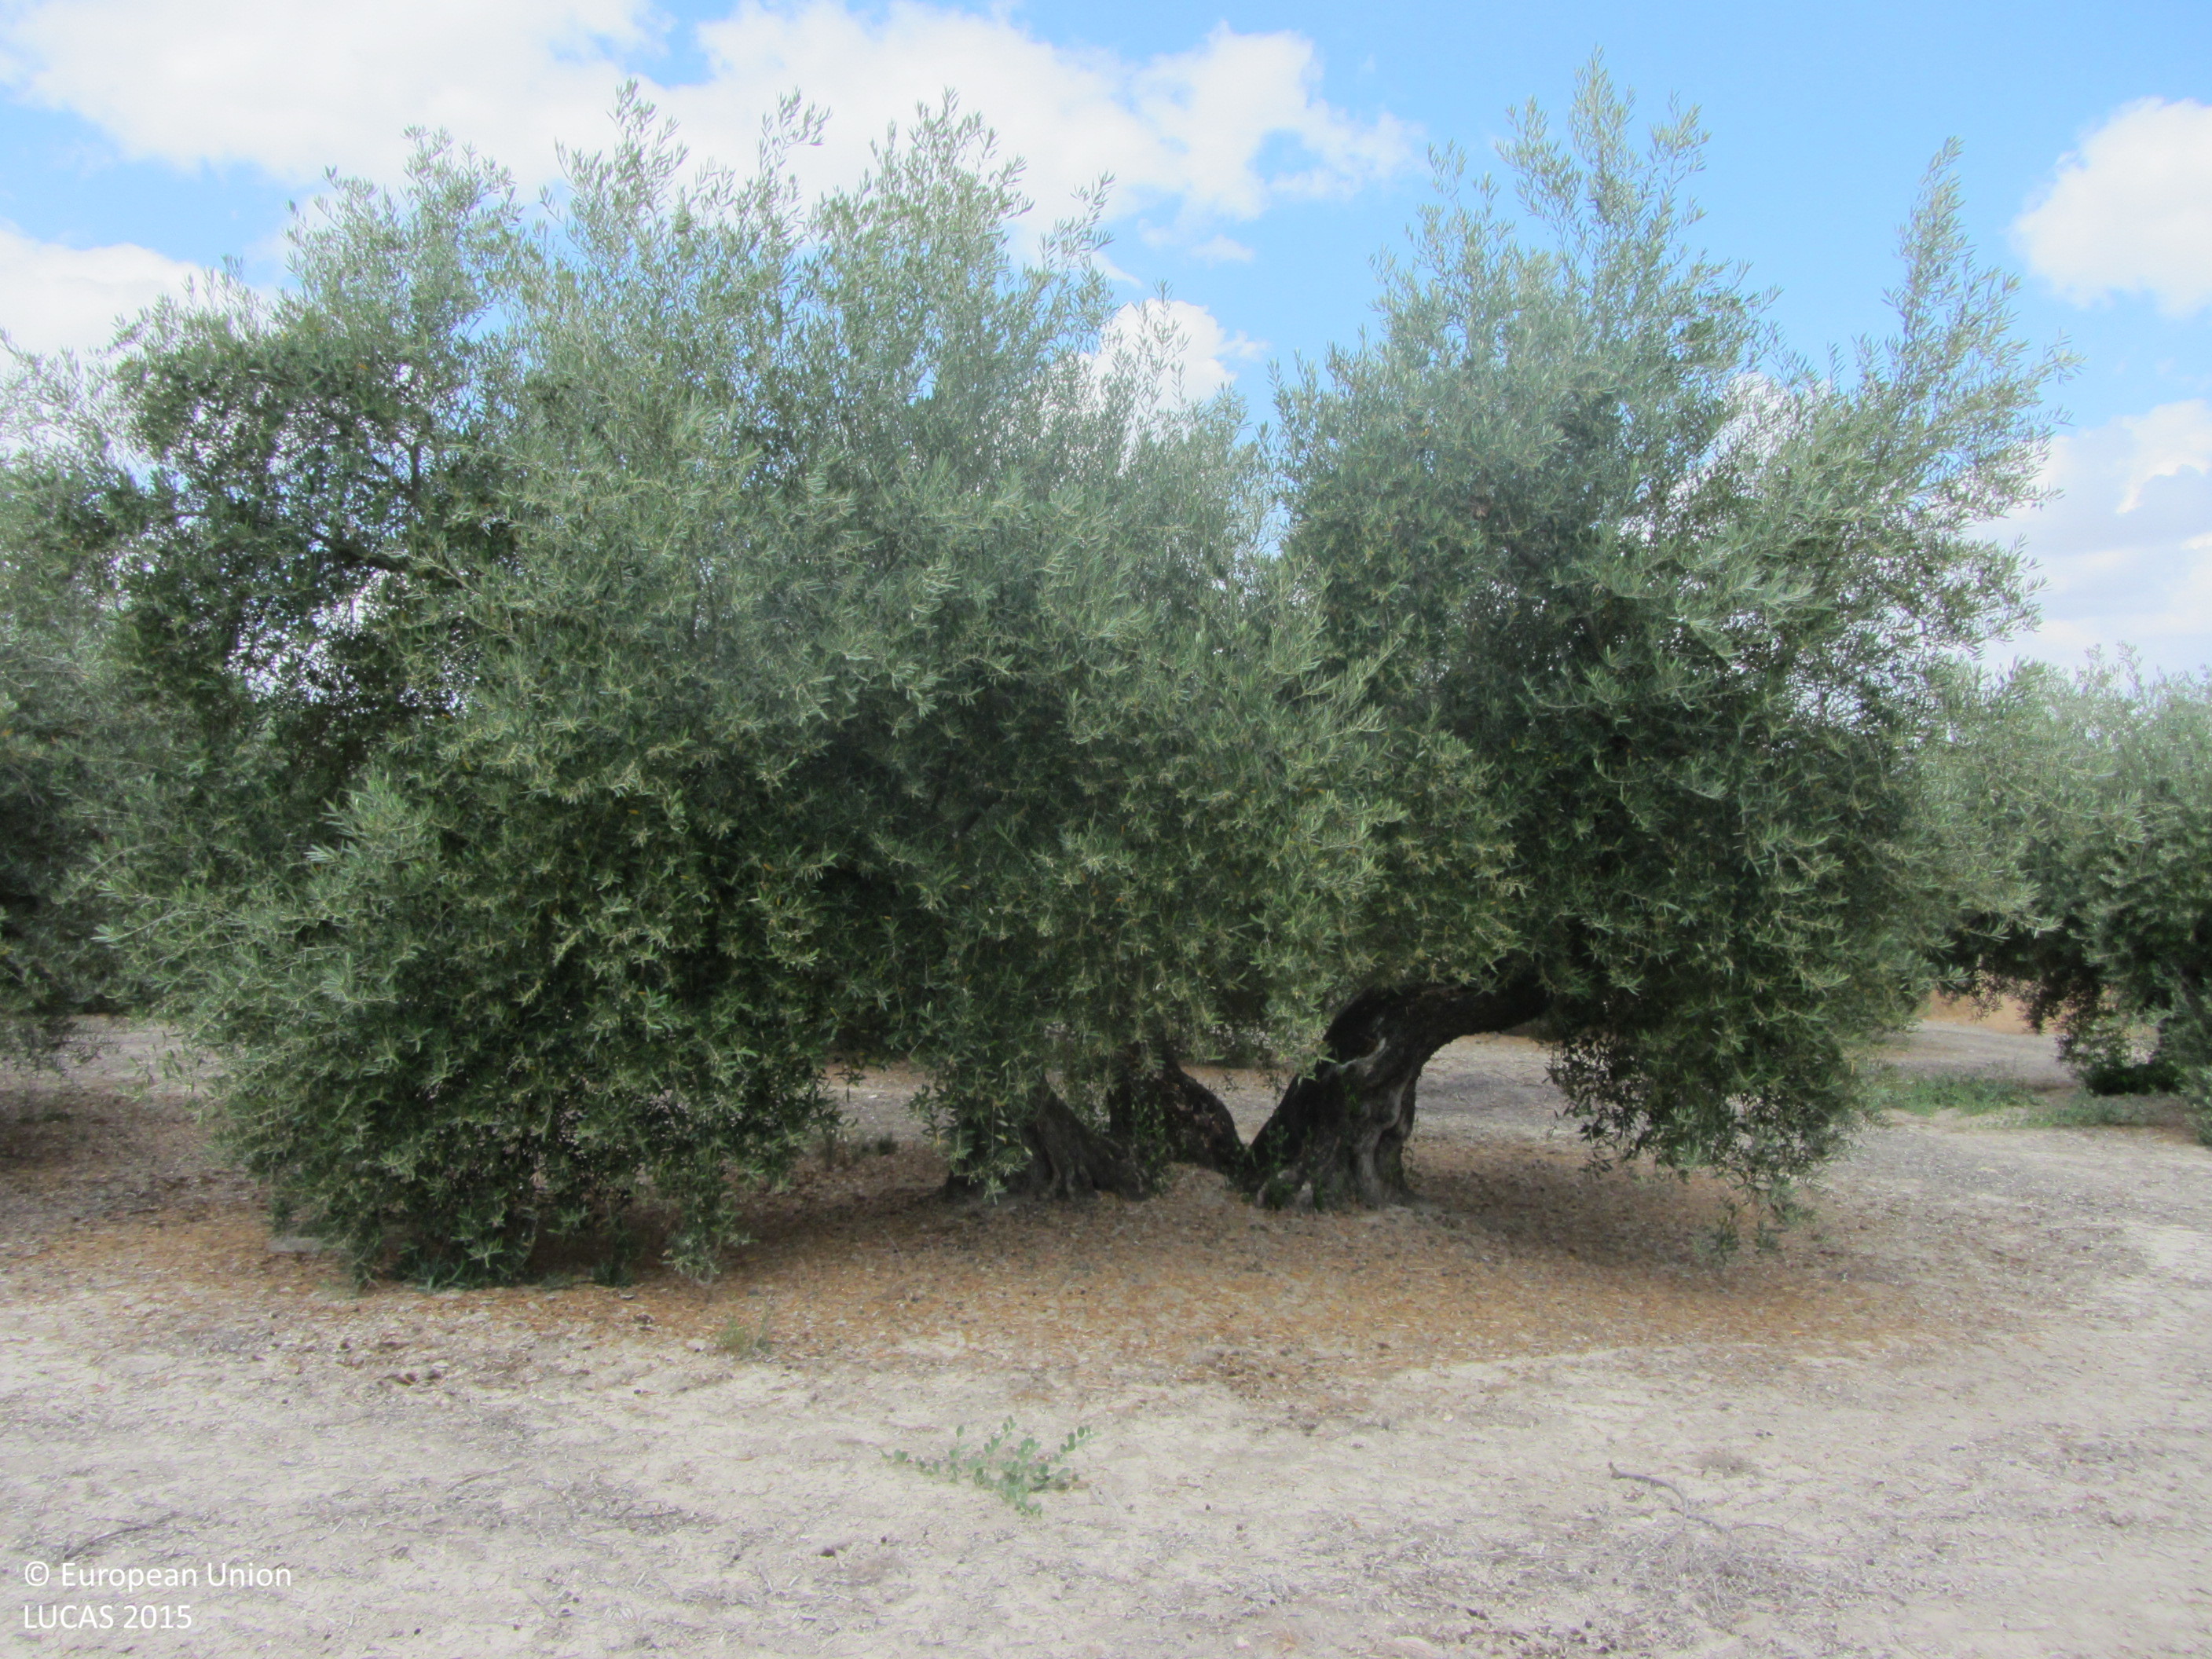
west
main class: Cropland
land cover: Olive groves
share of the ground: 25 - 50 %
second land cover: Other bare soil
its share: > 75 %
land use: Agriculture (excluding fallow land and kitchen gardens)
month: June
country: ES
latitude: 38.1380
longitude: -3.1088
